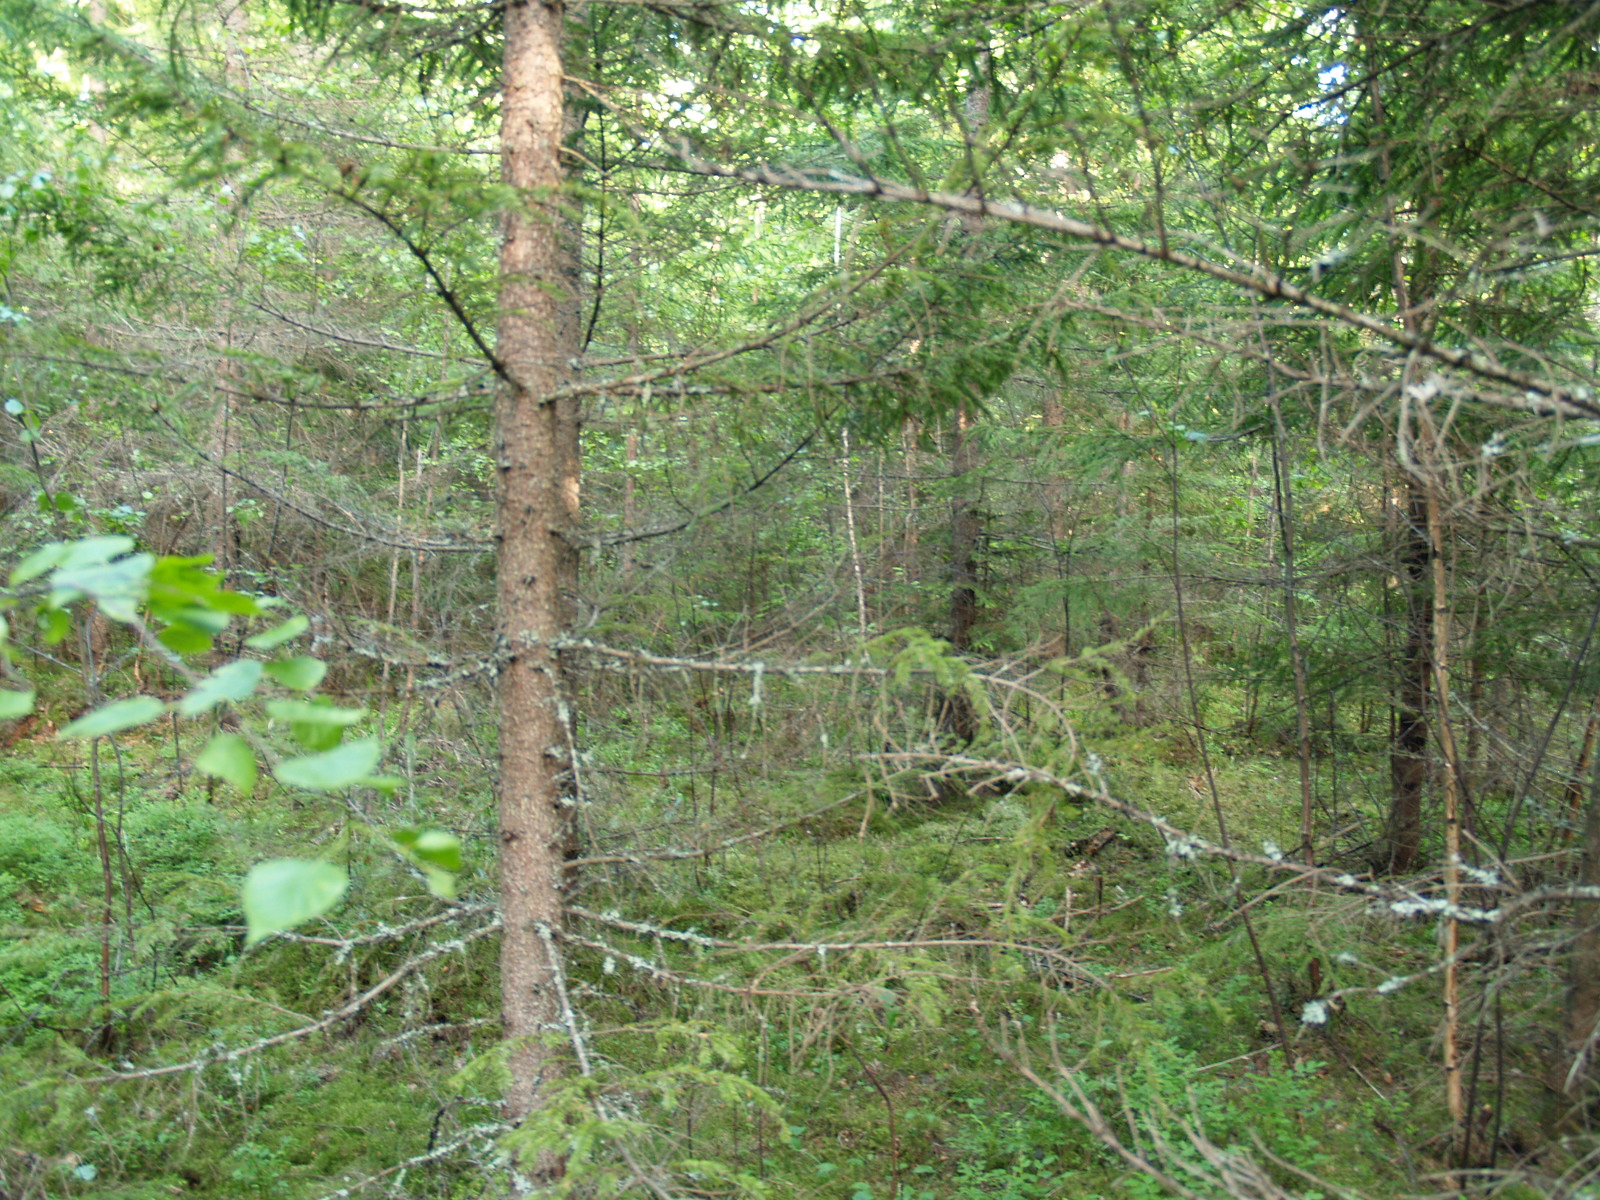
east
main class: Woodland
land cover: Spruce dominated coniferous woodland
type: hemiboreal forest and nemoral coniferous forest and mixed broadleaved-coniferous forest
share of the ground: > 75 %
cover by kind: coniferous forest trees 80 %, herbaceous plants 10 %, broadleaved forest trees 5 %, lichens and mosses 5 %
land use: Forestry
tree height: > 5 m
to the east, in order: Spruce dominated coniferous woodland; Broadleaved woodland; Ditches and canals; Broadleaved woodland; Grassland without tree/shrub cover
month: June
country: LV
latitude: 56.6353
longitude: 25.6274
